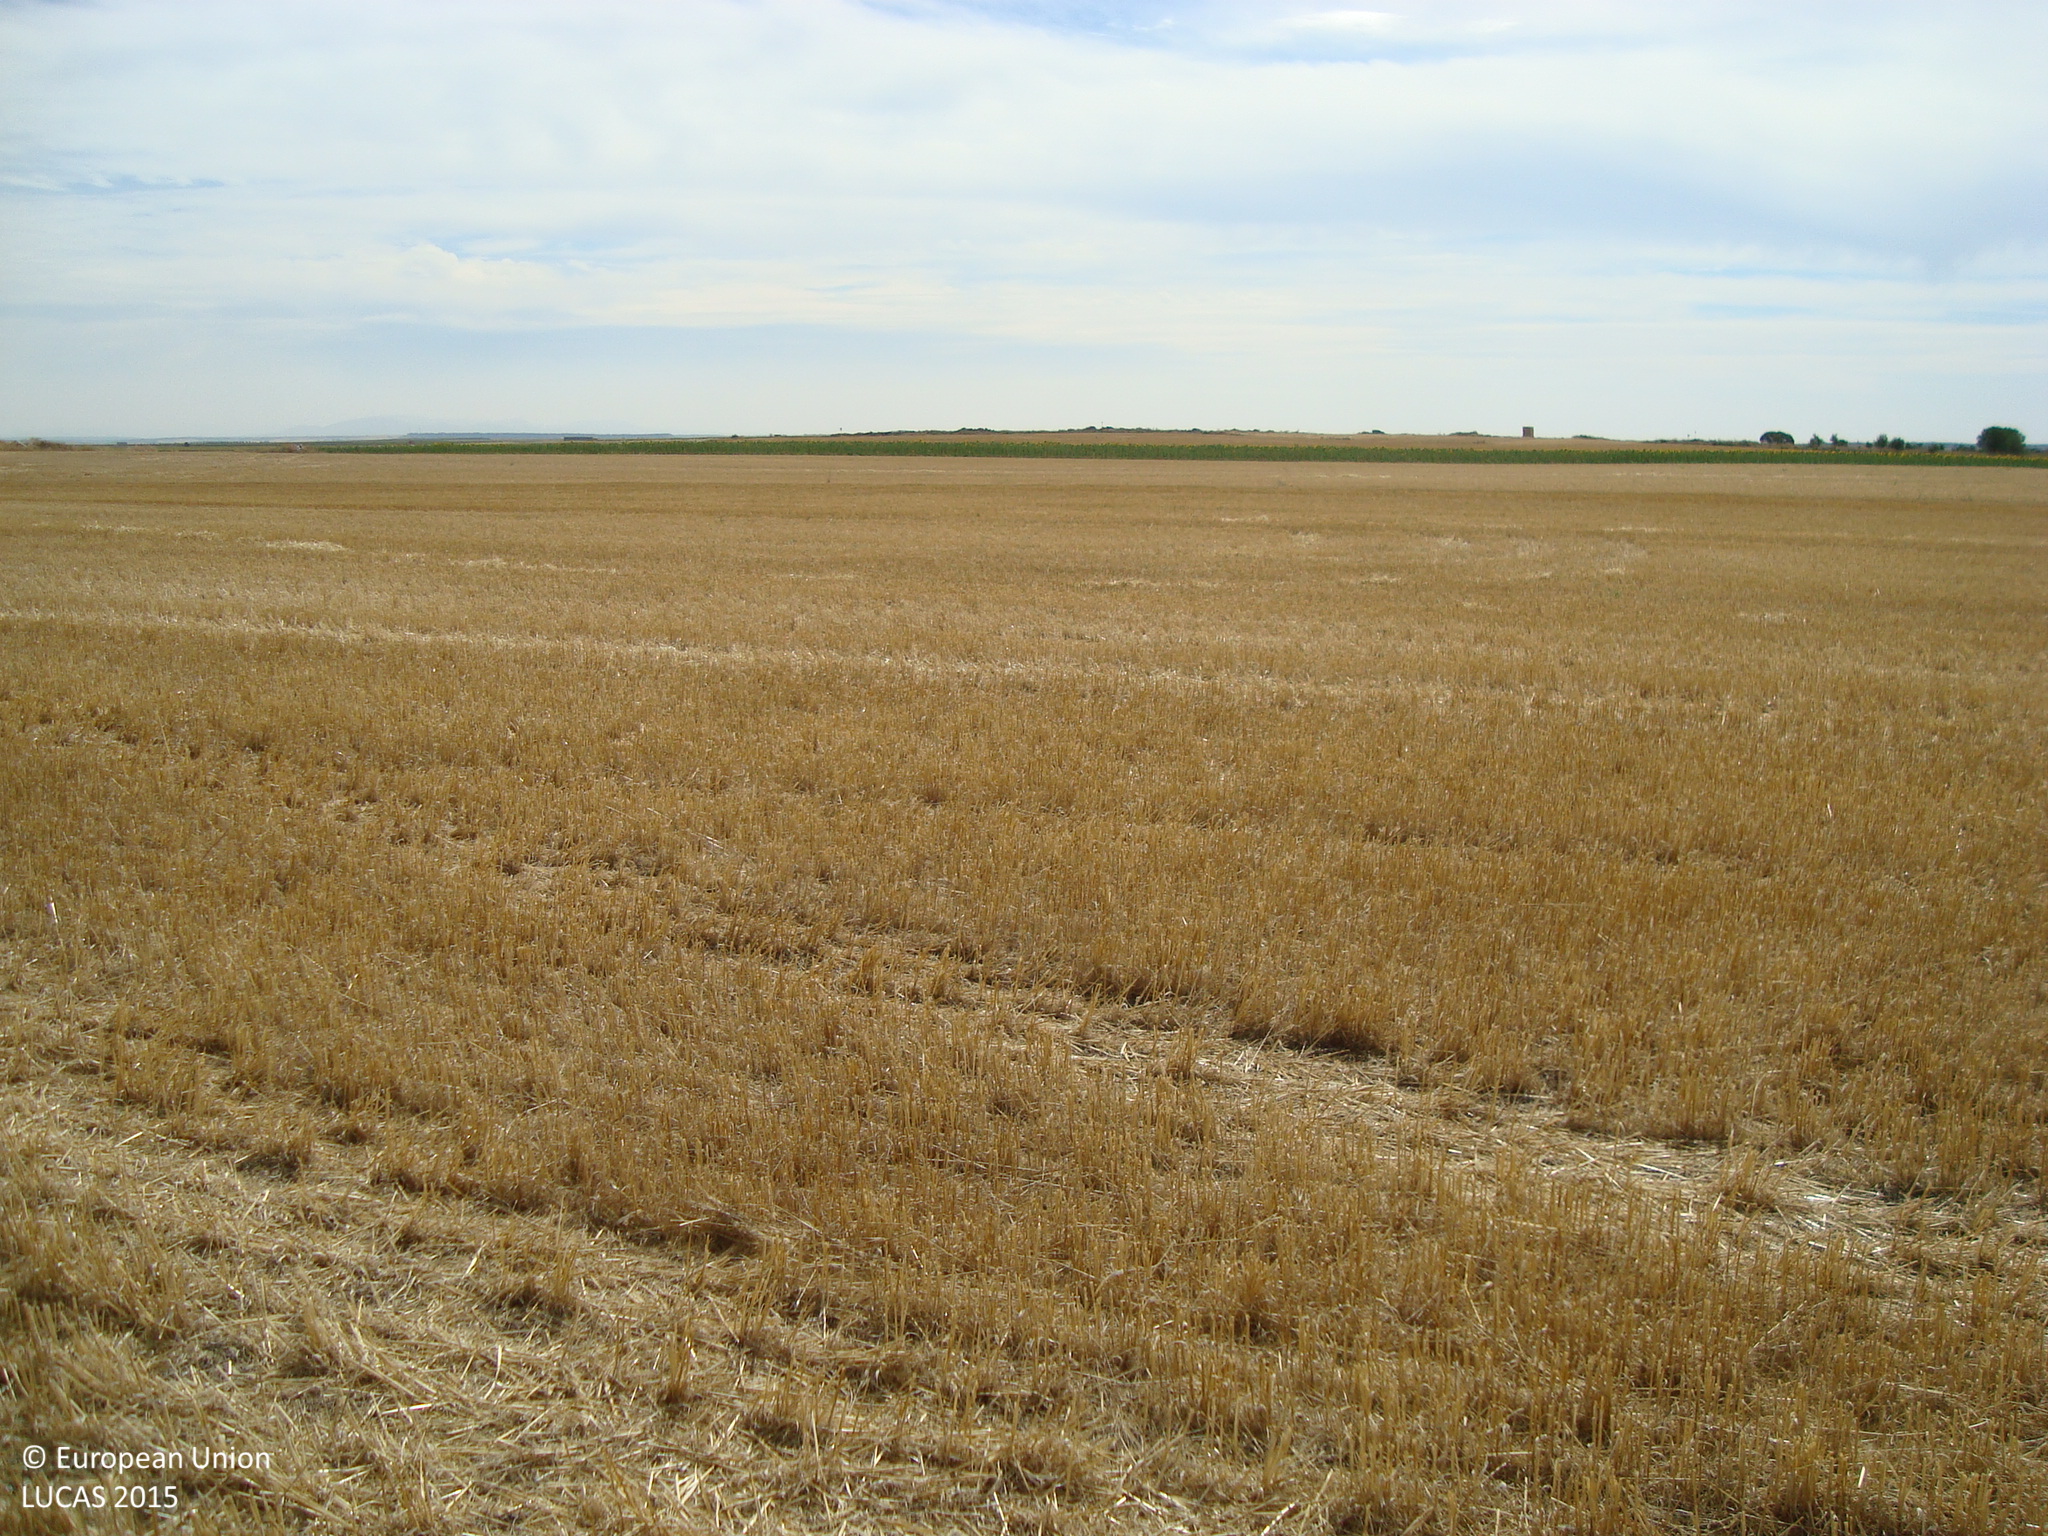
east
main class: Cropland
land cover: Barley
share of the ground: > 75 %
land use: Agriculture (excluding fallow land and kitchen gardens)
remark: Harvested field
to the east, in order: Barley; Sunflower; Spontaneously vegetated surfaces; Common wheat
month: July
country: ES
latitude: 41.8974
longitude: -3.8591
